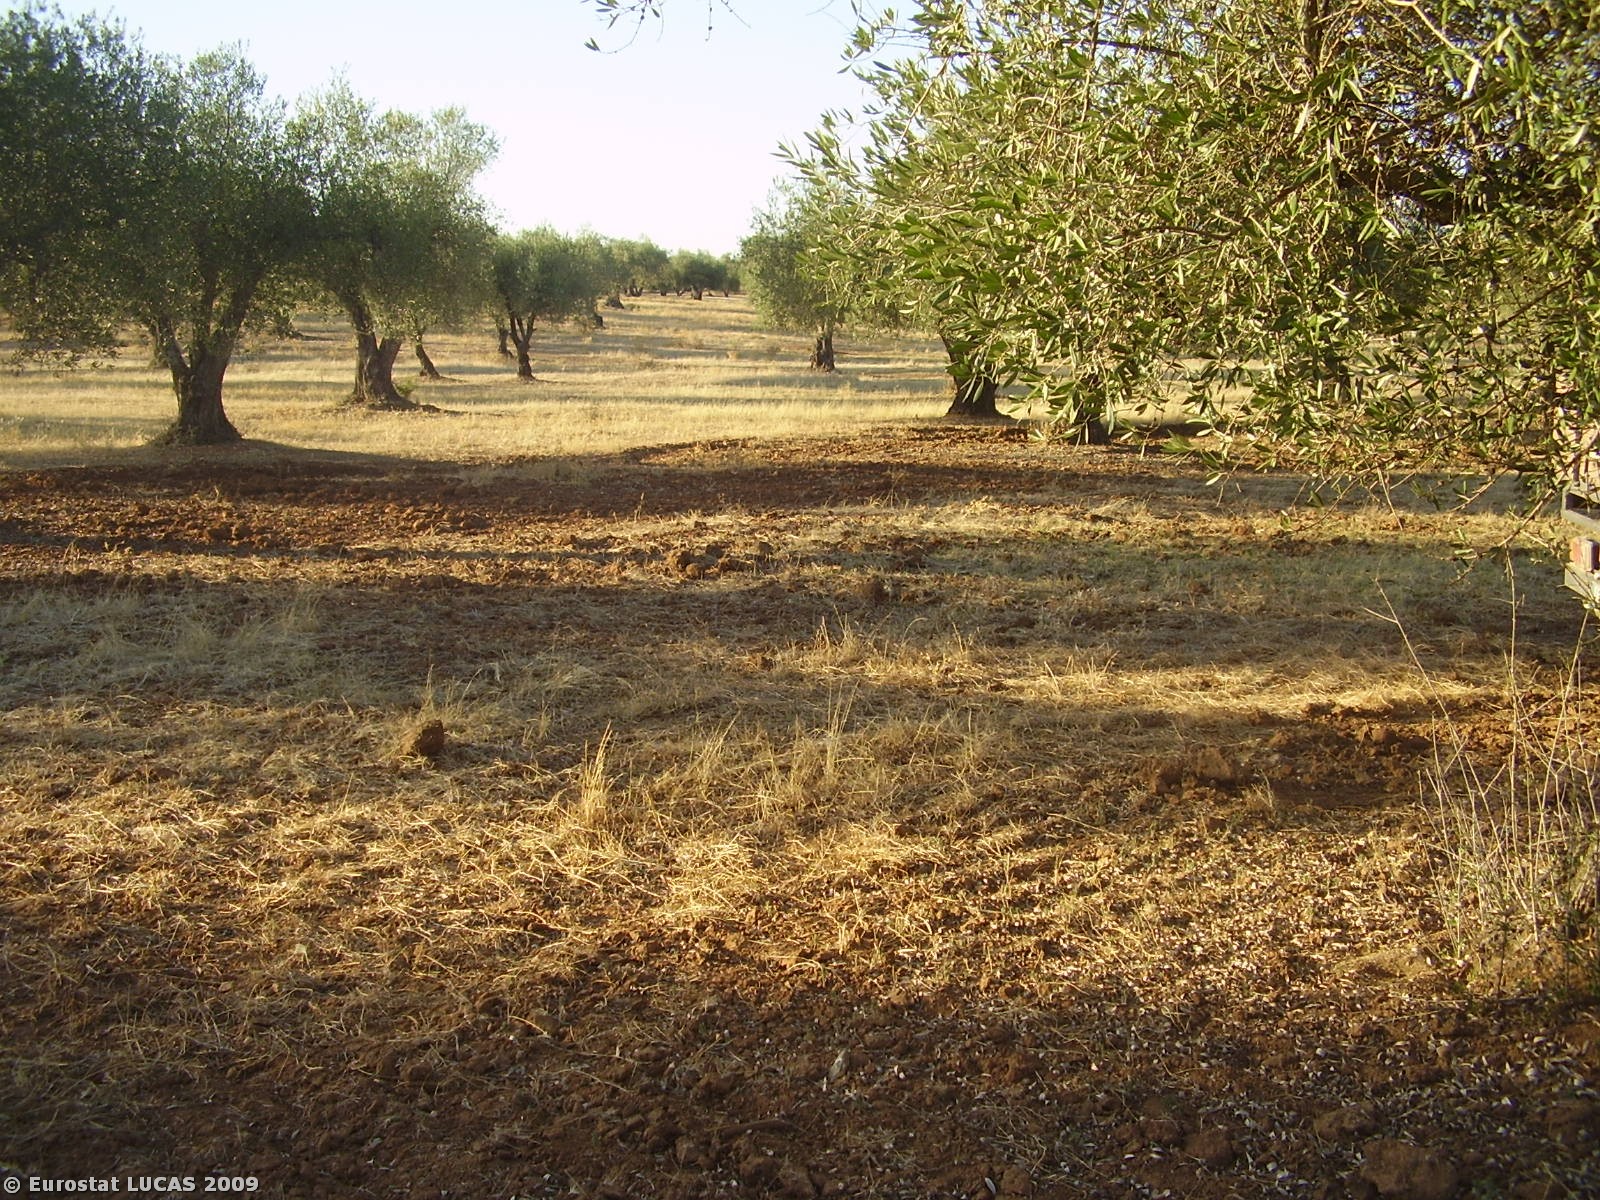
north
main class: Cropland
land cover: Olive groves
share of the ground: 10 - 25 %
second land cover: Spontaneously vegetated surfaces
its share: 10 - 25 %
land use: Agriculture (excluding fallow land and kitchen gardens)
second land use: Fallow land
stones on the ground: 25 - 50 %
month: August
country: PT
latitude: 38.0419
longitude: -7.5573
